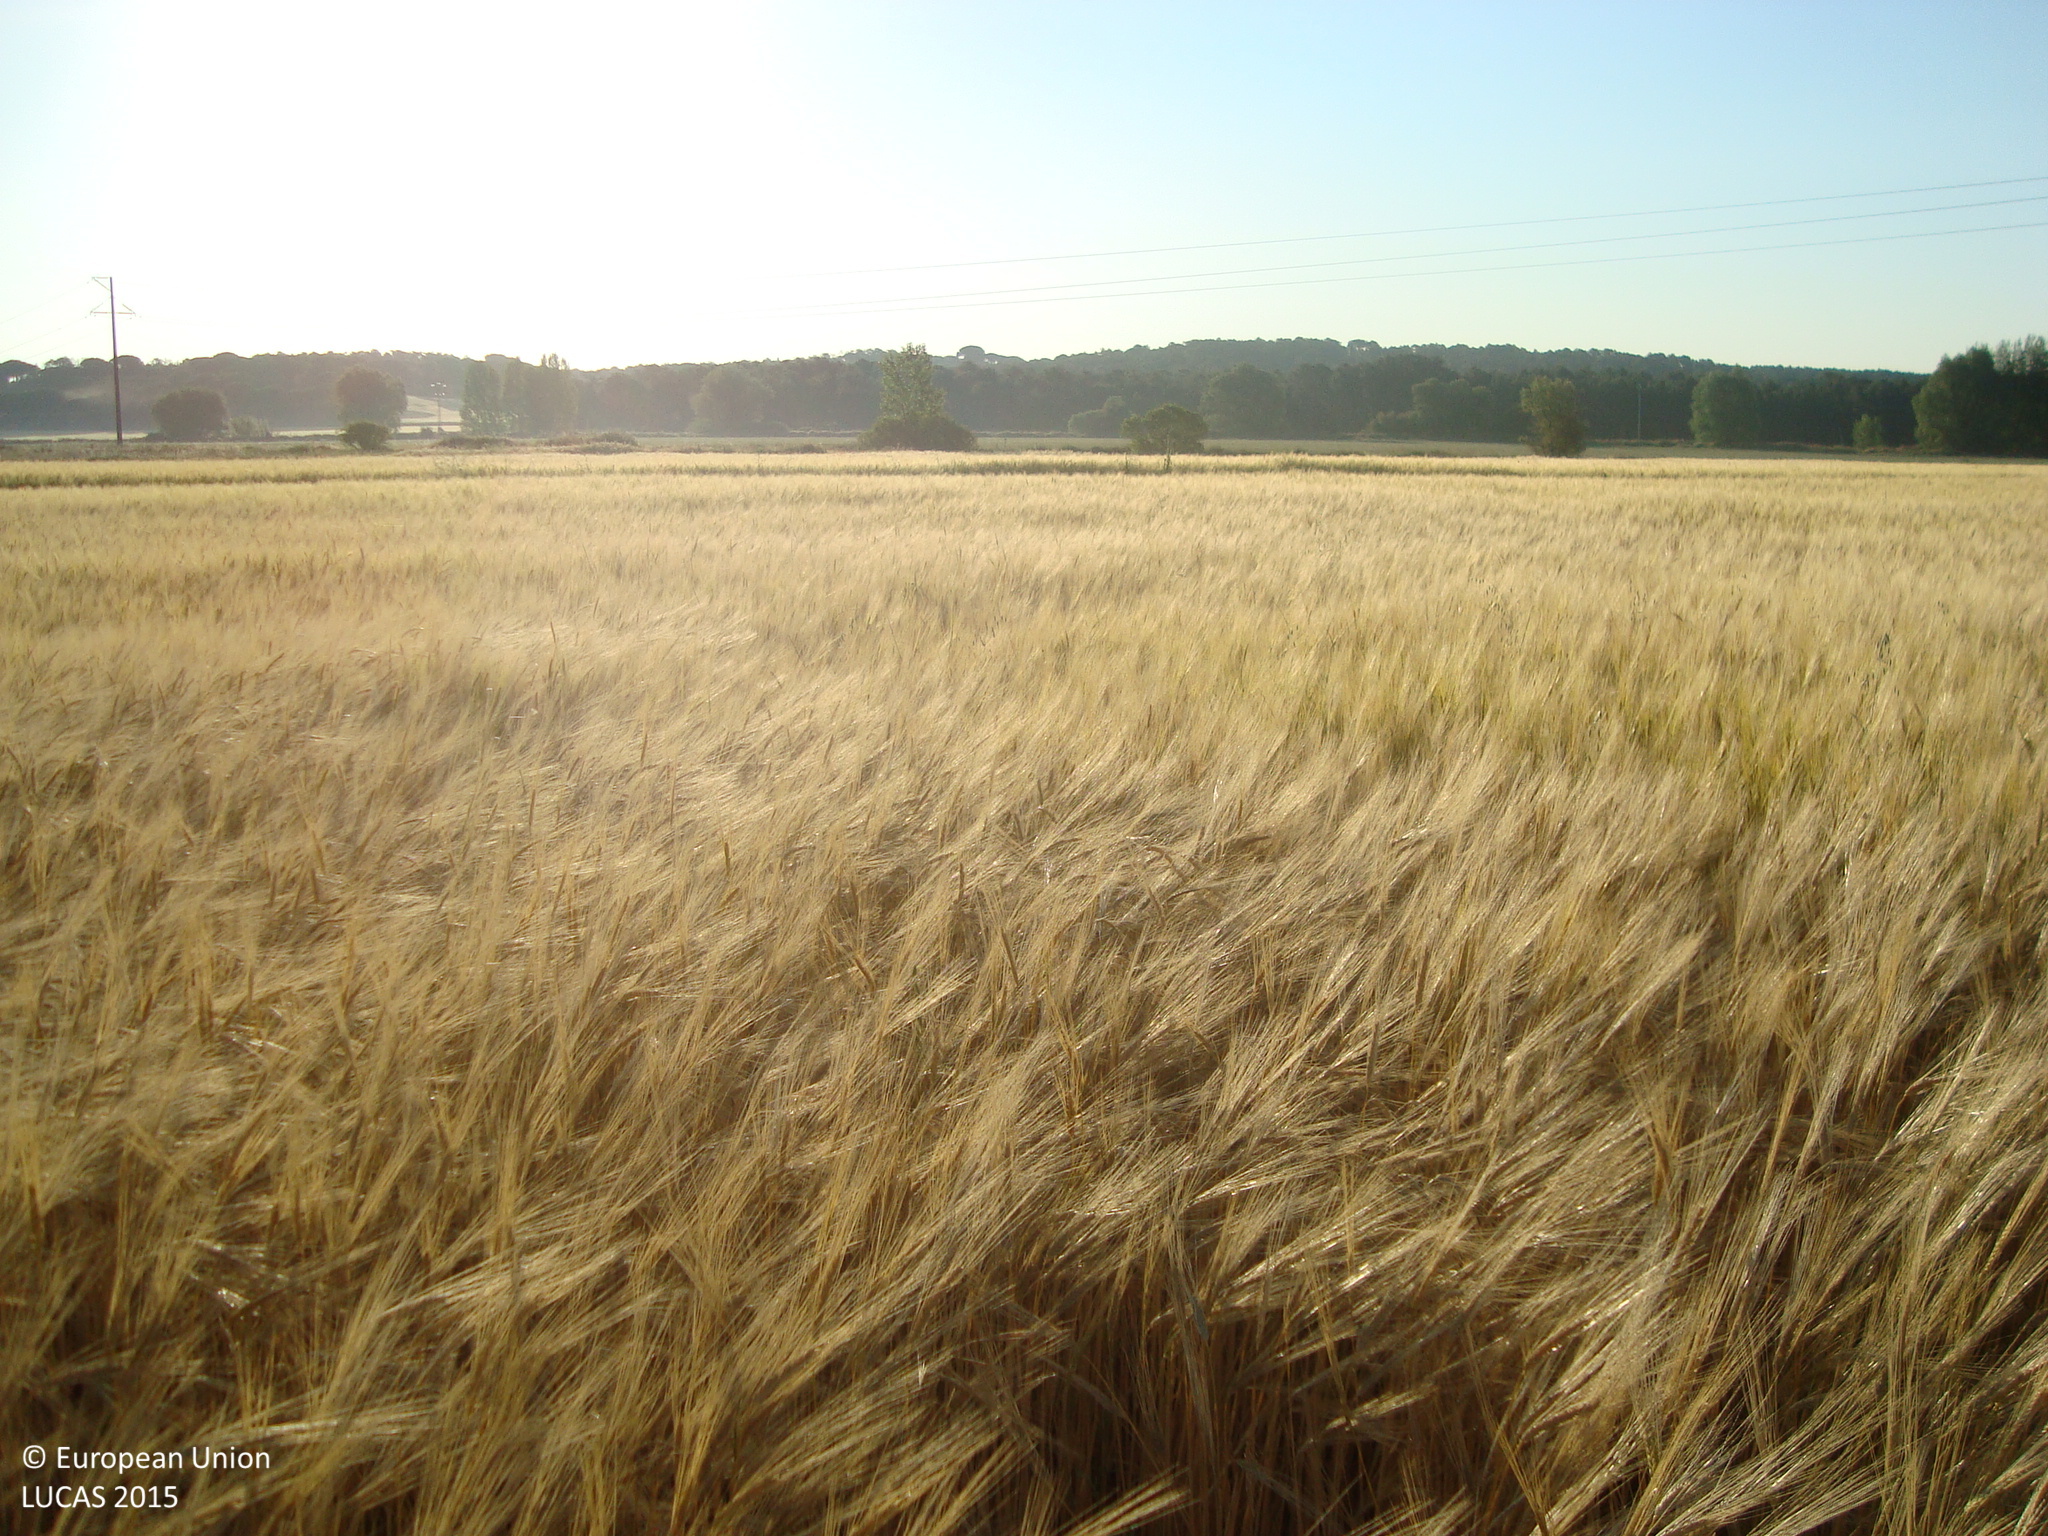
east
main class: Cropland
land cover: Barley
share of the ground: > 75 %
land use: Agriculture (excluding fallow land and kitchen gardens)
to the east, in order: Barley; Rivers and streams; Barley; Electric lines; Barley; Grassland with sparse tree/shrub cover; Rivers and streams; Grassland with sparse tree/shrub cover; Tracks; Grassland with sparse tree/shrub cover; Common wheat
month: June
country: ES
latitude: 41.7252
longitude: -3.6488
